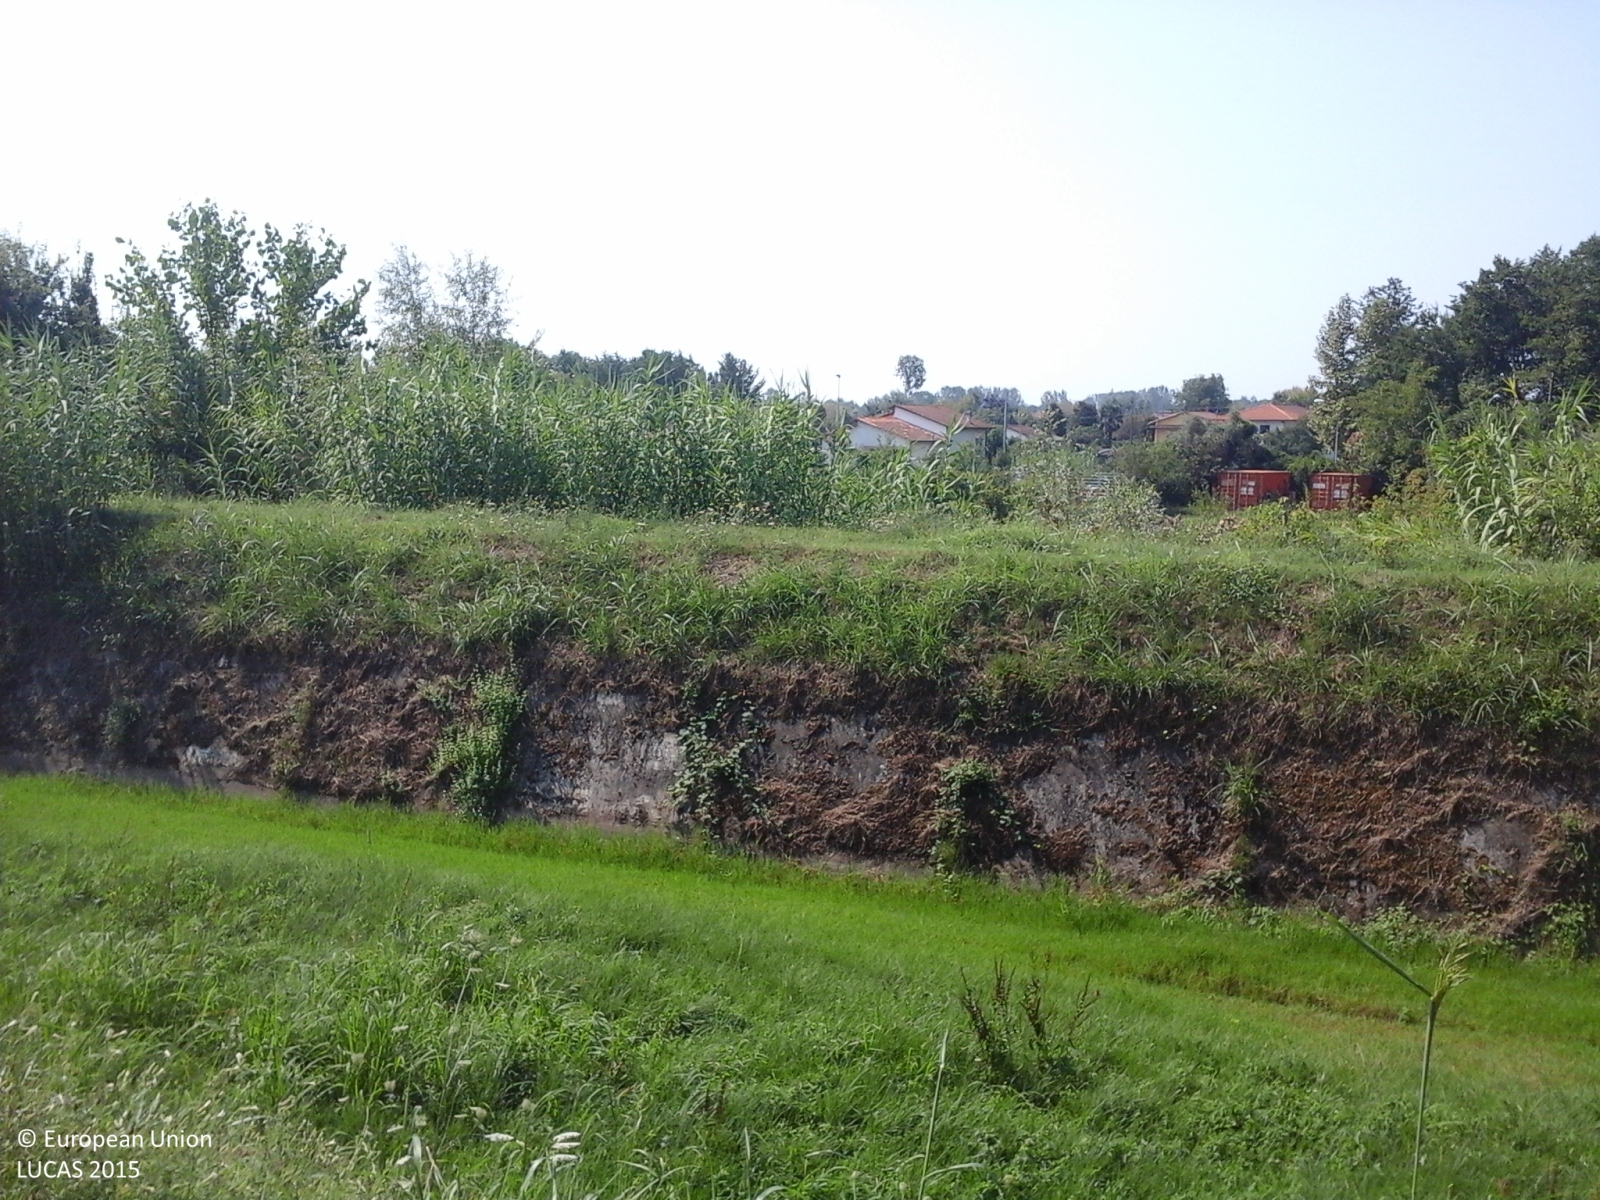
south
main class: Woodland
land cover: Broadleaved woodland
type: thermophilous deciduous forest
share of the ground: > 75 %
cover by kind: broadleaved forest trees 100 %
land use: Semi-natural and natural areas not in use
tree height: > 5 m
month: August
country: IT
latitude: 43.9896
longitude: 10.1617
